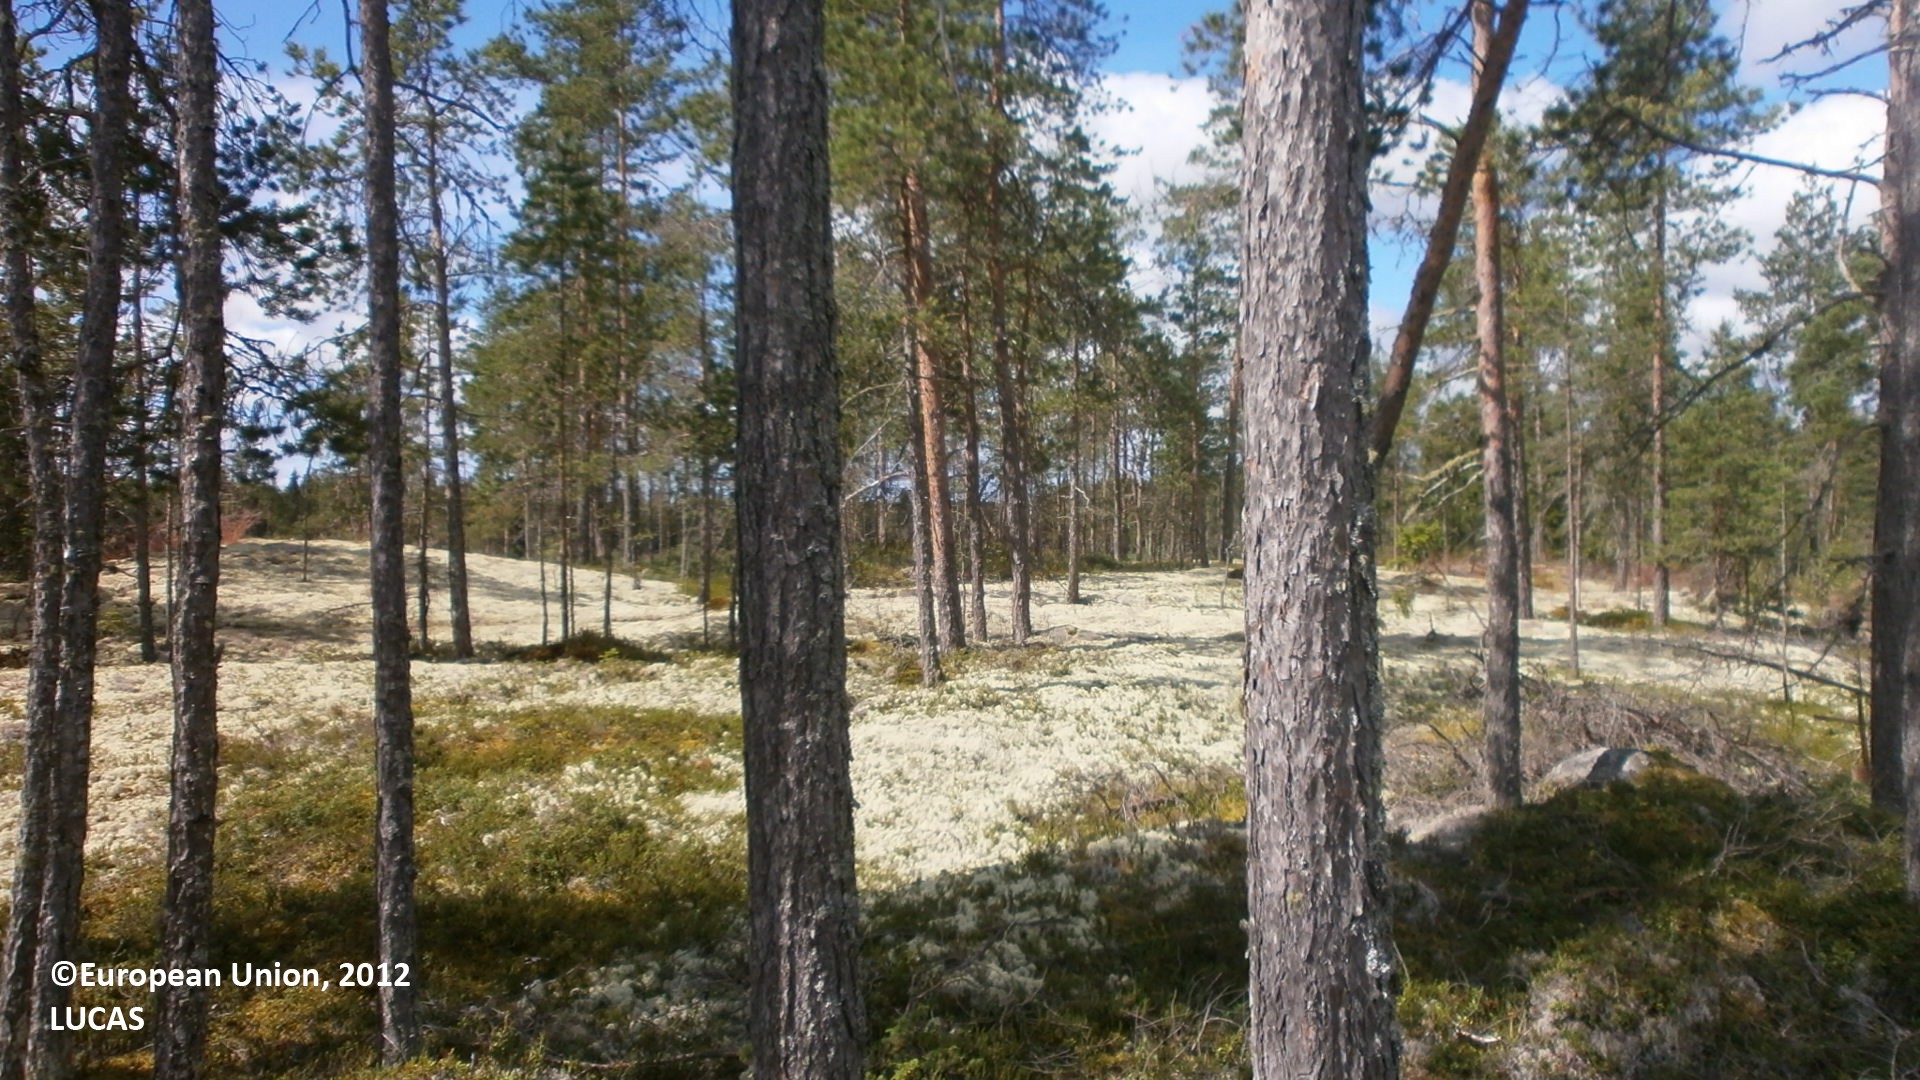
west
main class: Shrubland
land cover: Shrubland without tree cover
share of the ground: > 75 %
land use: Forestry
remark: Clear cut
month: July
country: FI
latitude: 64.0204
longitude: 23.7075
